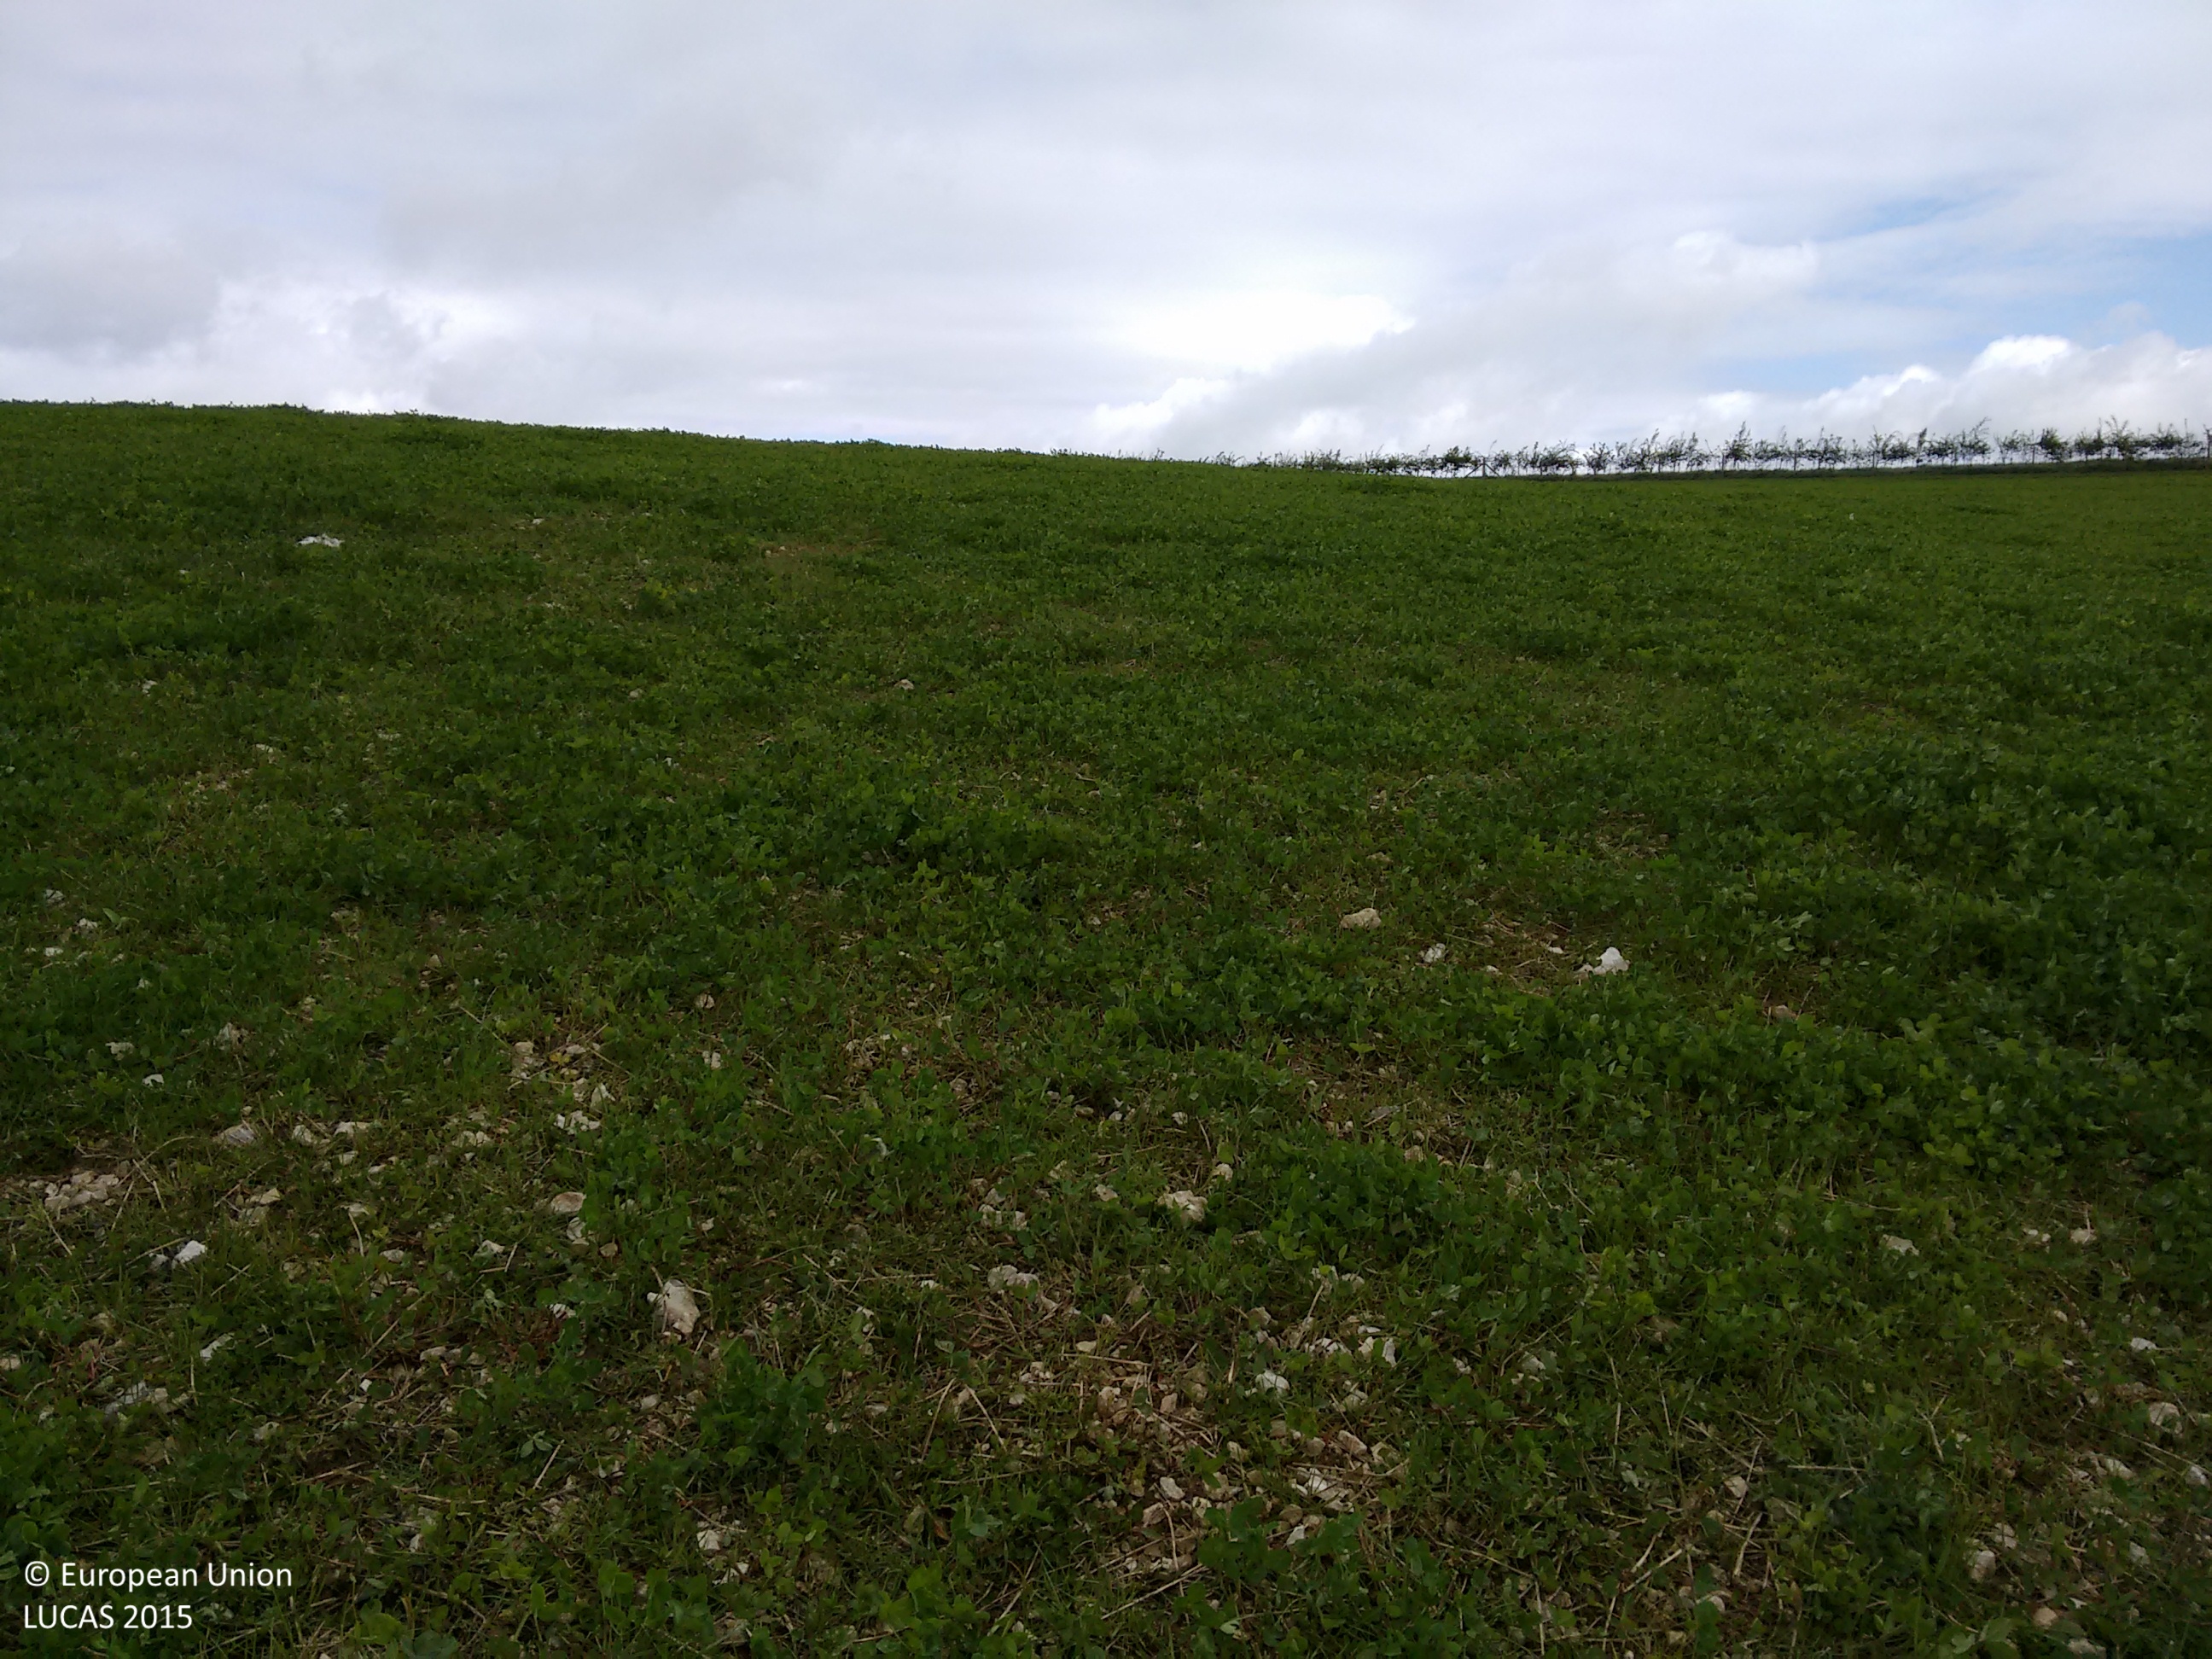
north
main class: Cropland
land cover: Clovers
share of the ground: > 75 %
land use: Agriculture (excluding fallow land and kitchen gardens)
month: May
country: GB
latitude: 53.3224
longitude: -0.1066
